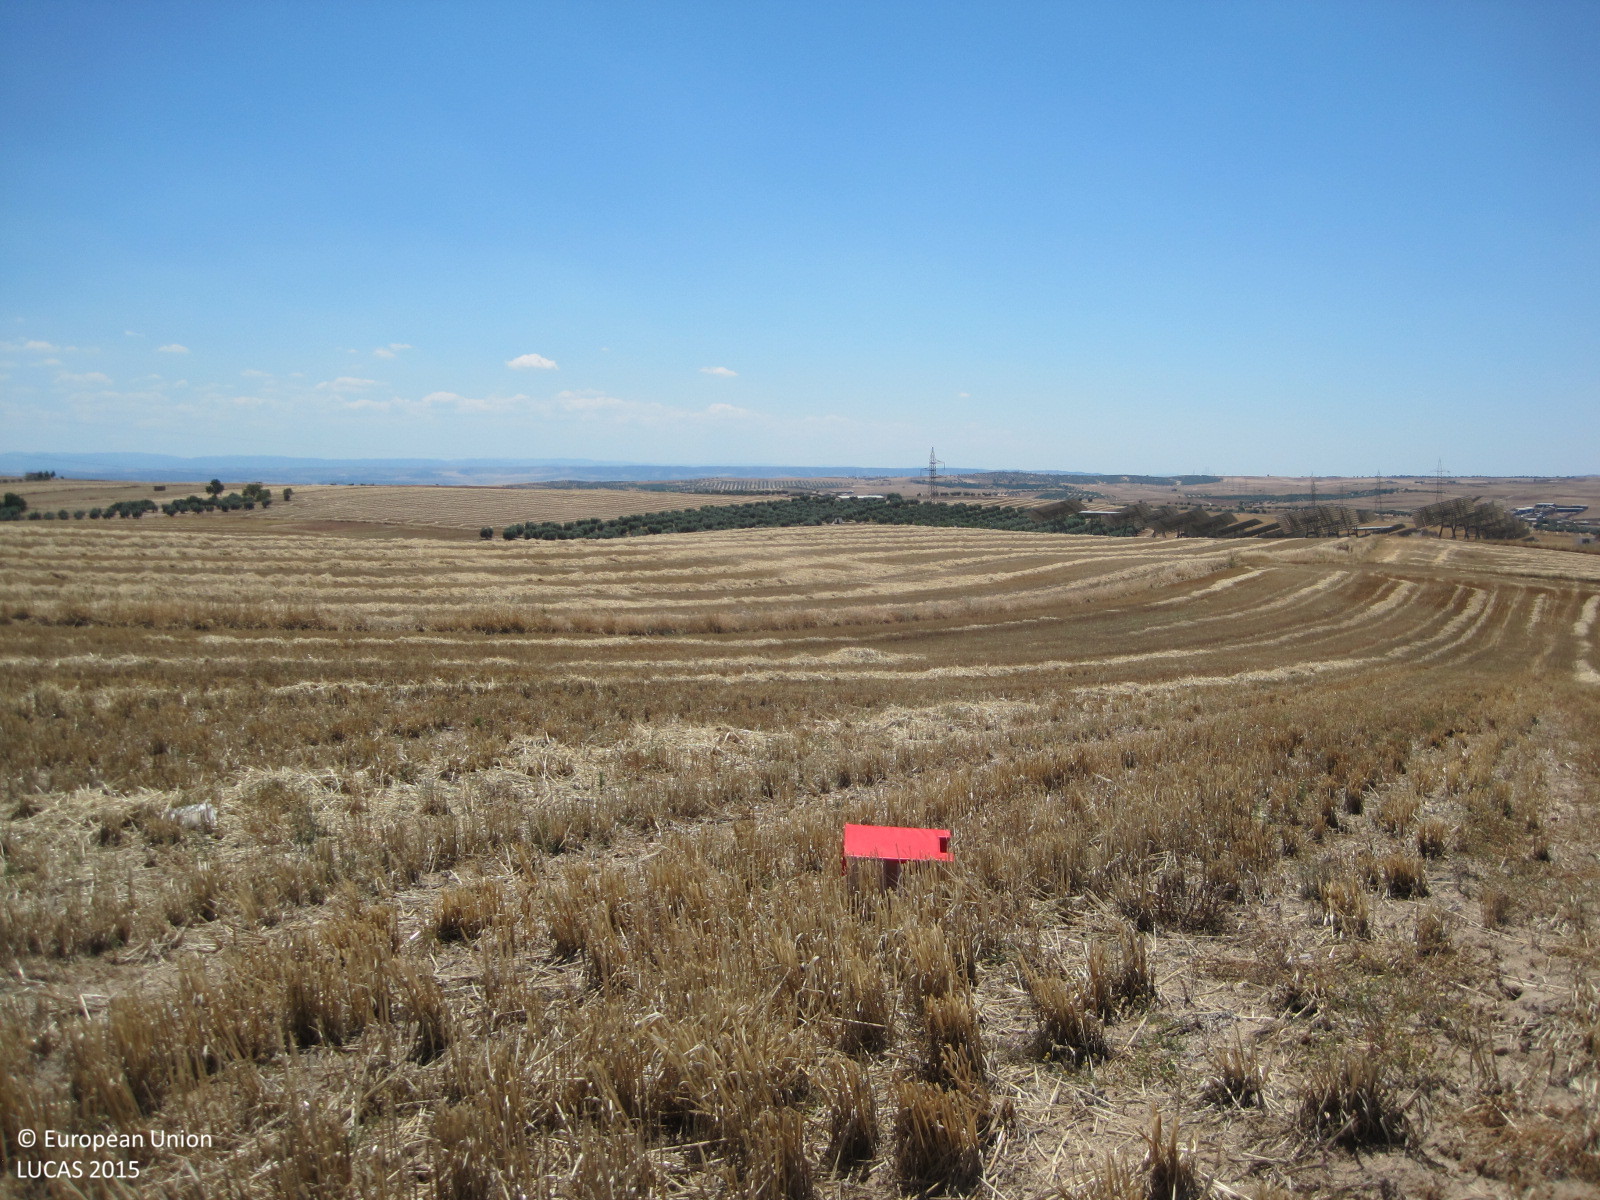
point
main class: Cropland
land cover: Barley
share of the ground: < 10 %
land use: Agriculture (excluding fallow land and kitchen gardens)
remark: Harvested field
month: June
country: ES
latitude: 39.8966
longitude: -4.2720
